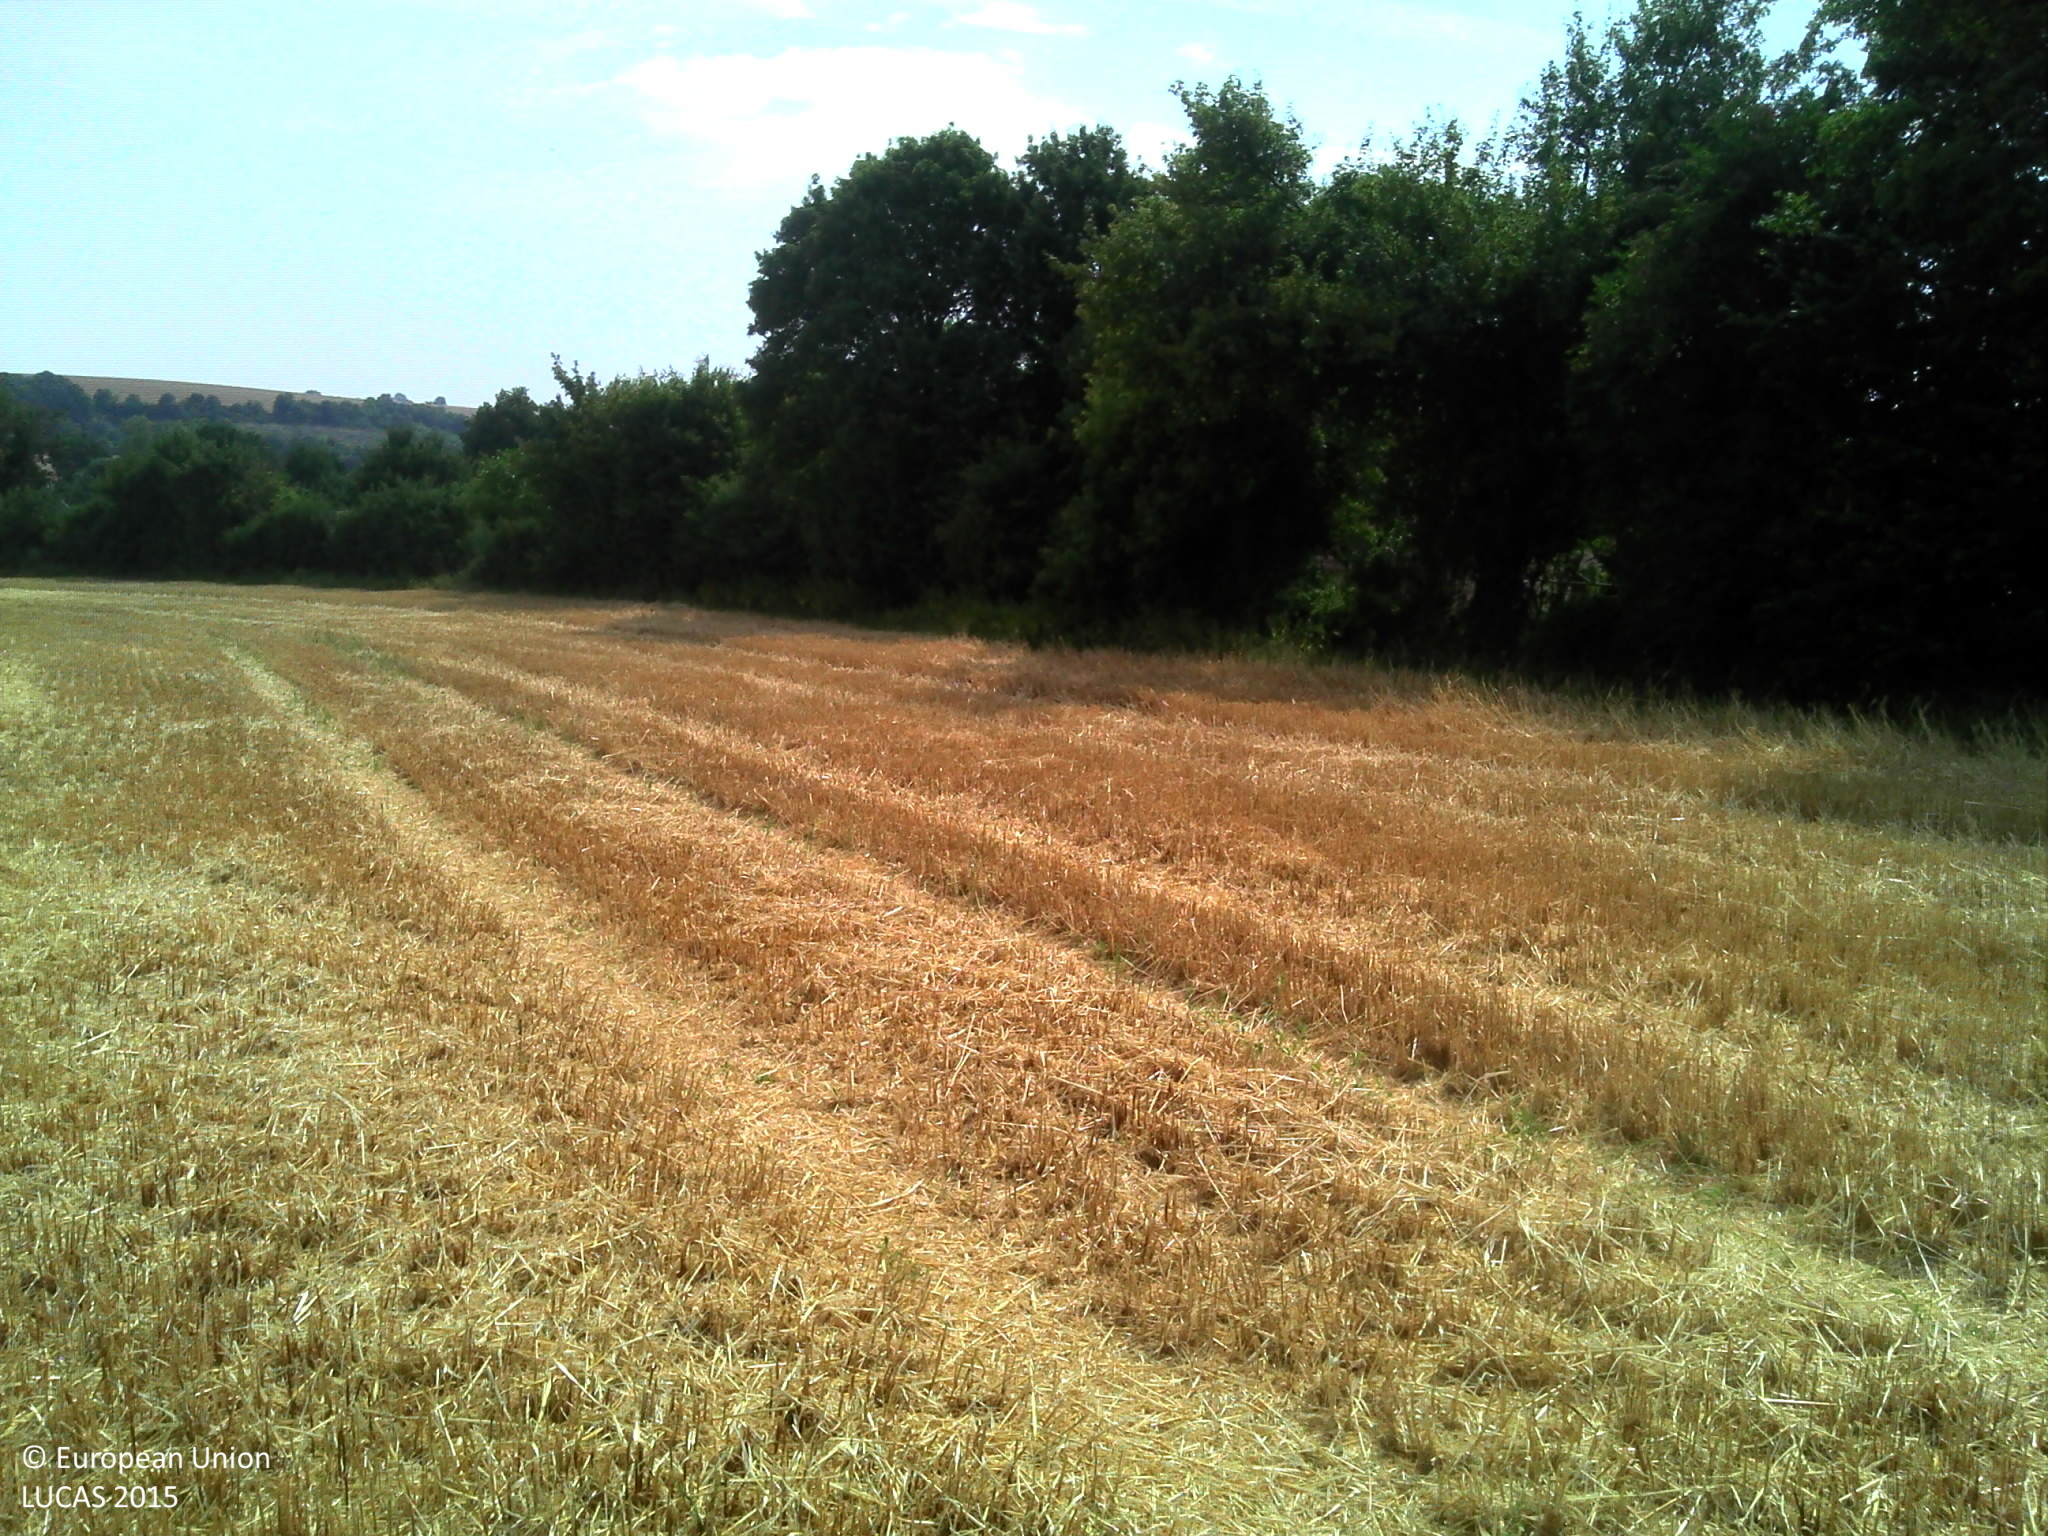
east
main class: Cropland
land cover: Barley
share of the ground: > 75 %
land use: Agriculture (excluding fallow land and kitchen gardens)
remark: Harvested field
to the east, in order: Barley; Grass margins; Fences; Broadleaved woodland; Grassland without tree/shrub cover; Artificial constructions in urban areas; Grassland without tree/shrub cover; Fences; Grassland without tree/shrub cover; Fences; Grassland without tree/shrub cover
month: July
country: FR
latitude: 47.6517
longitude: 3.4855
